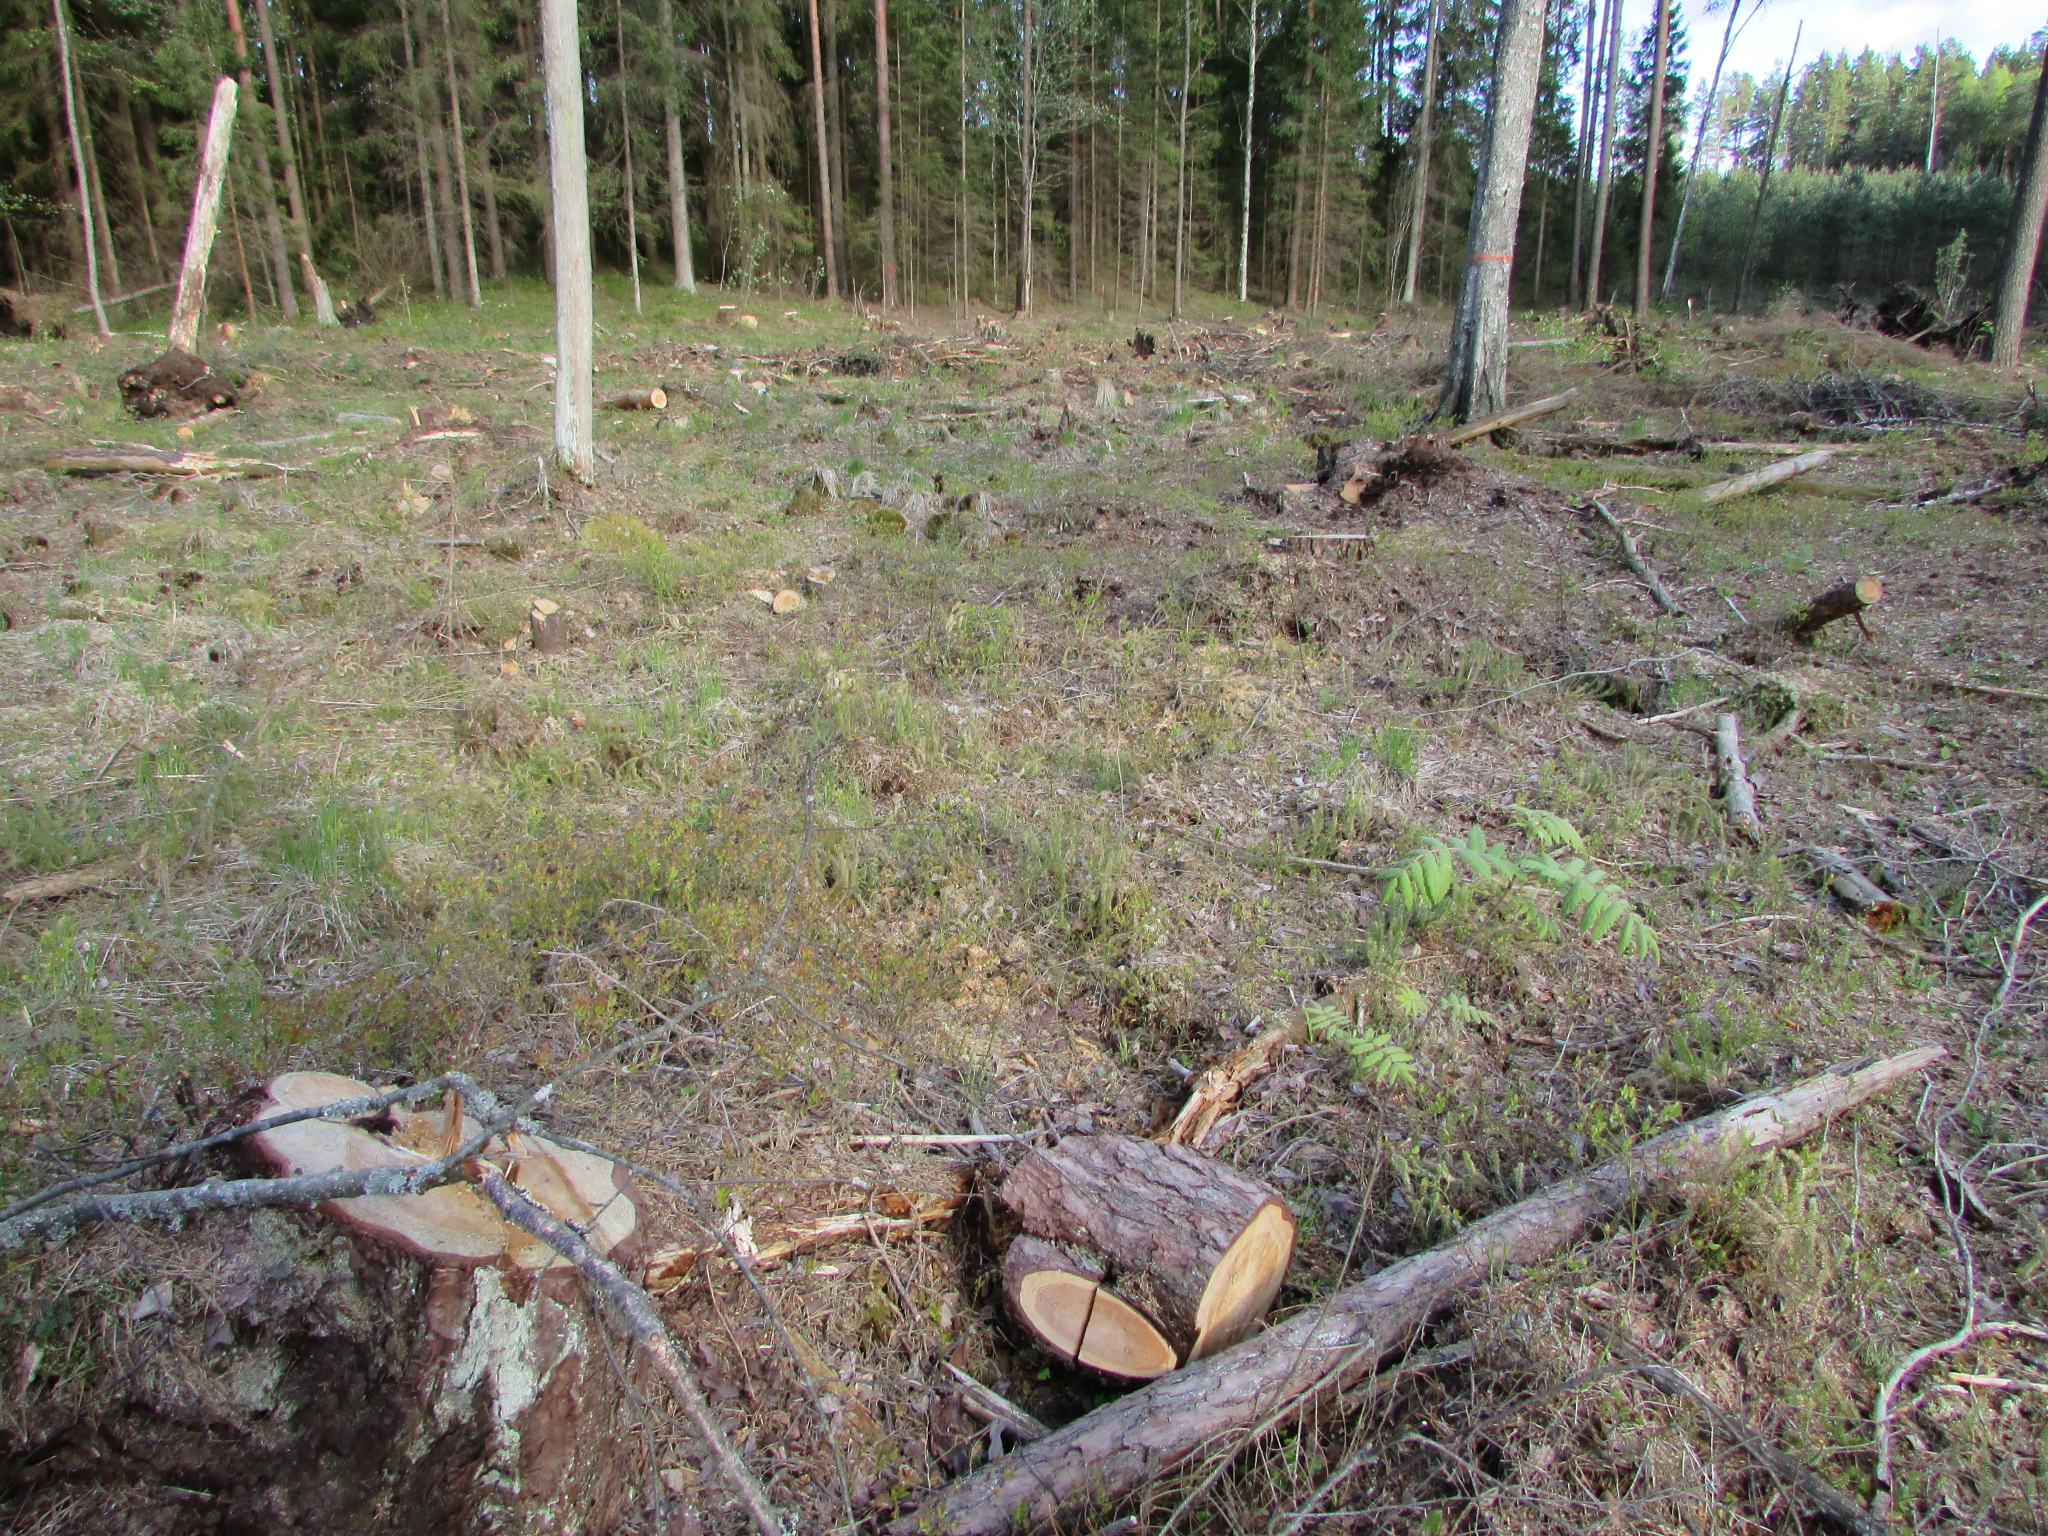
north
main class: Grassland
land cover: Spontaneously vegetated surfaces
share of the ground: 25 - 50 %
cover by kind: unconsolidated bare surface 60 %, herbaceous plants 30 %
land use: Forestry
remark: Clear cut
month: May
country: LV
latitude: 56.1618
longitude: 27.1575
